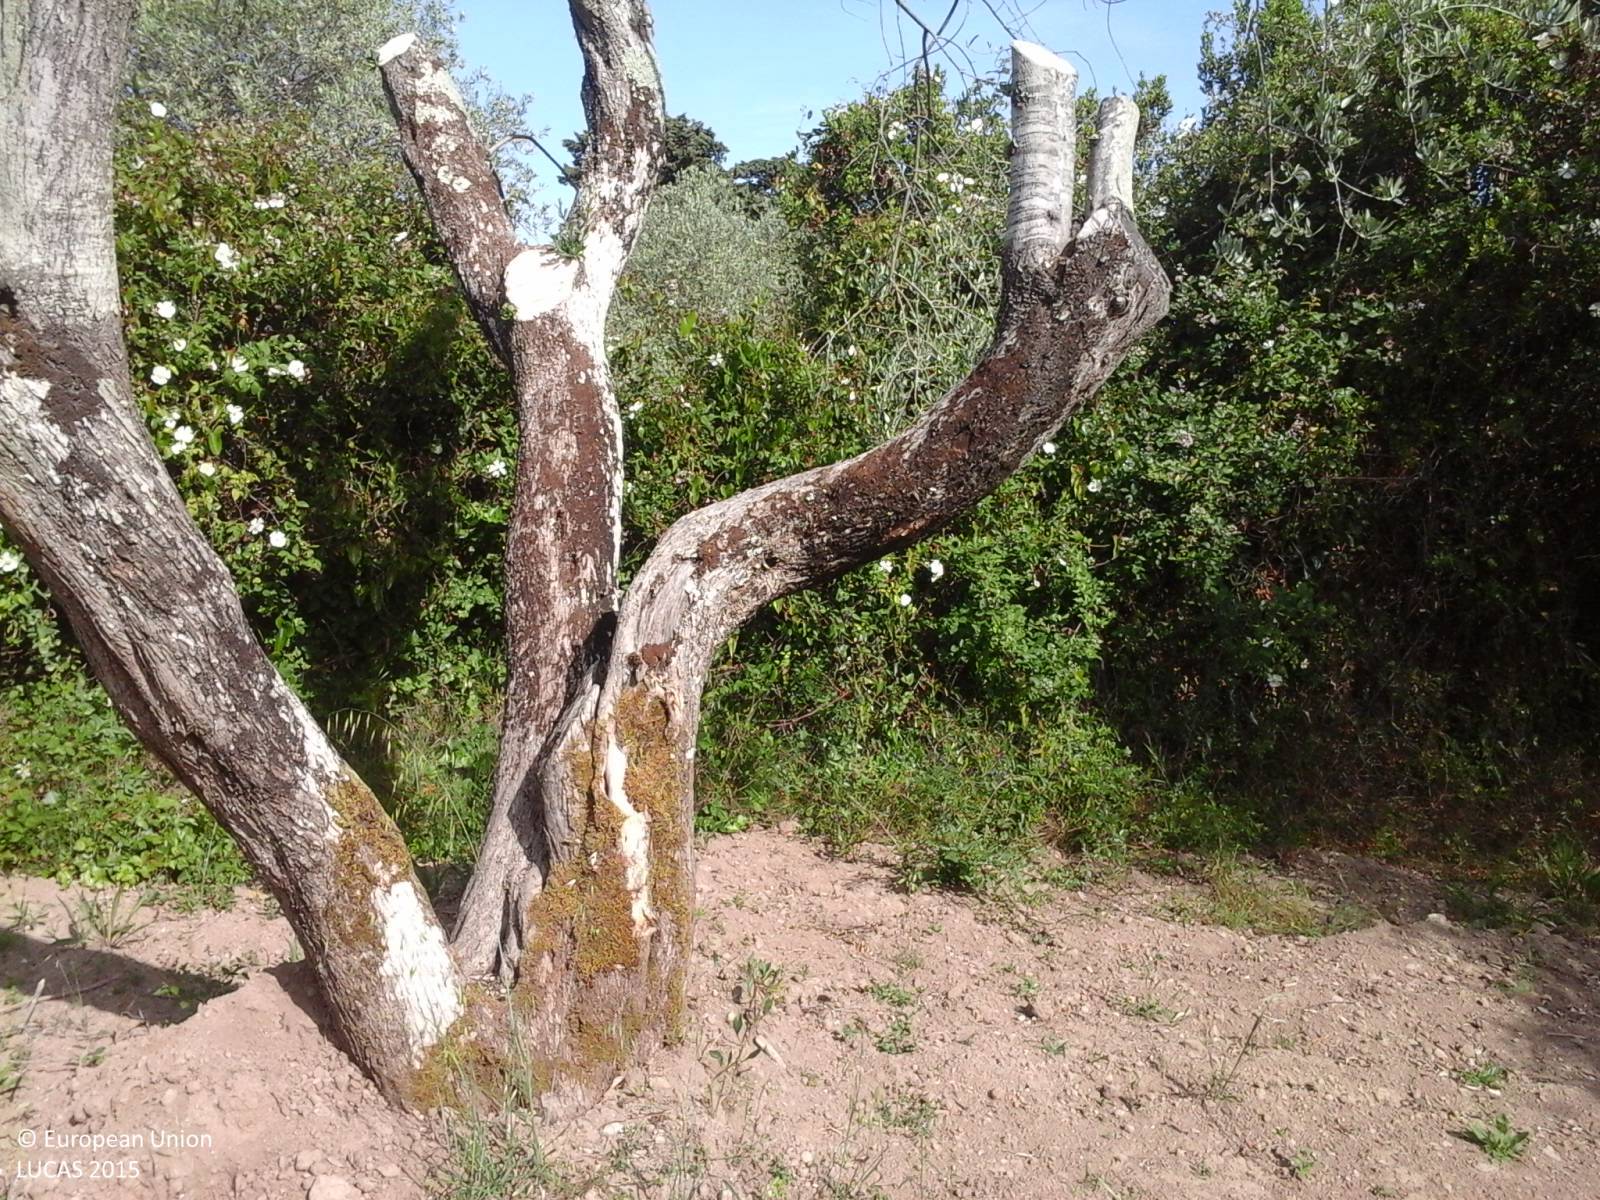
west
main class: Cropland
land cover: Olive groves
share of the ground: > 75 %
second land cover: Grassland without tree/shrub cover
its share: > 75 %
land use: Agriculture (excluding fallow land and kitchen gardens)
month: May
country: IT
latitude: 40.7638
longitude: 8.5734
